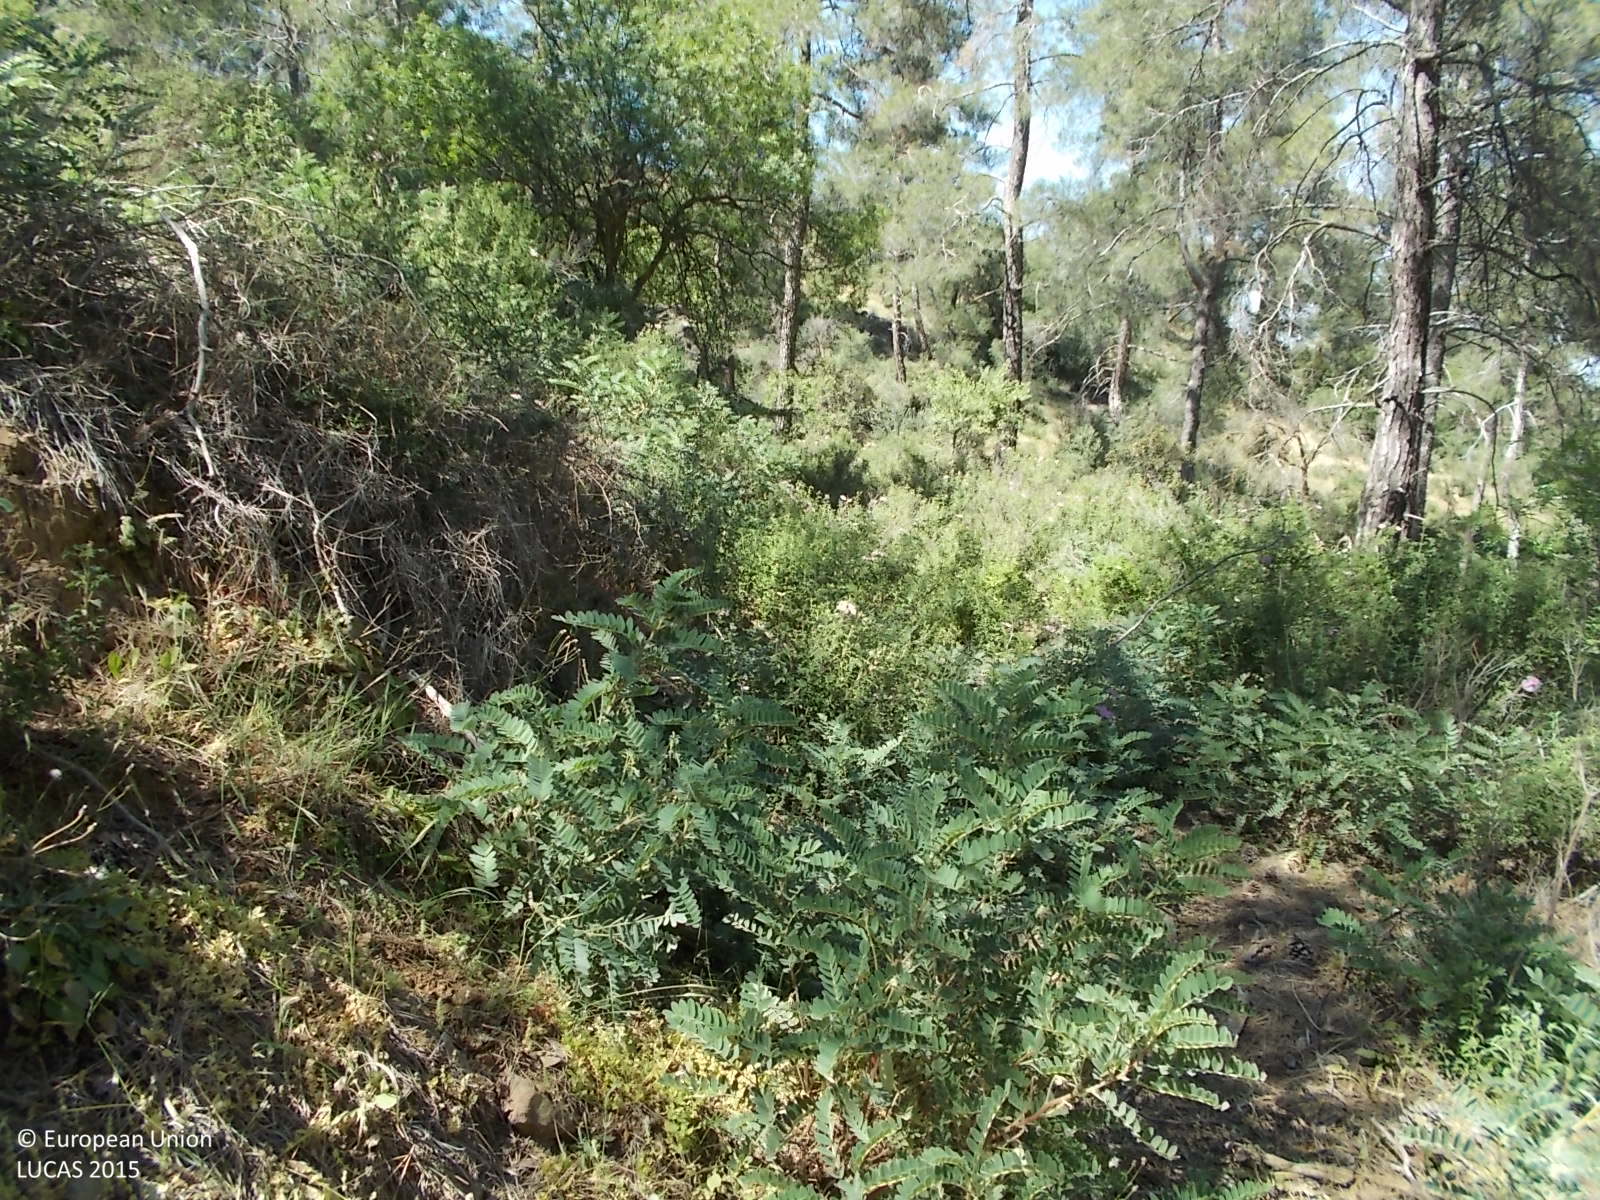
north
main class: Woodland
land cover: Pine dominated coniferous woodland
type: coniferous forest of the mediterranean region
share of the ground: > 75 %
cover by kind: coniferous forest trees 100 %
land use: Semi-natural and natural areas not in use
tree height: > 5 m
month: May
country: CY
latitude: 34.9470
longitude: 33.2075
